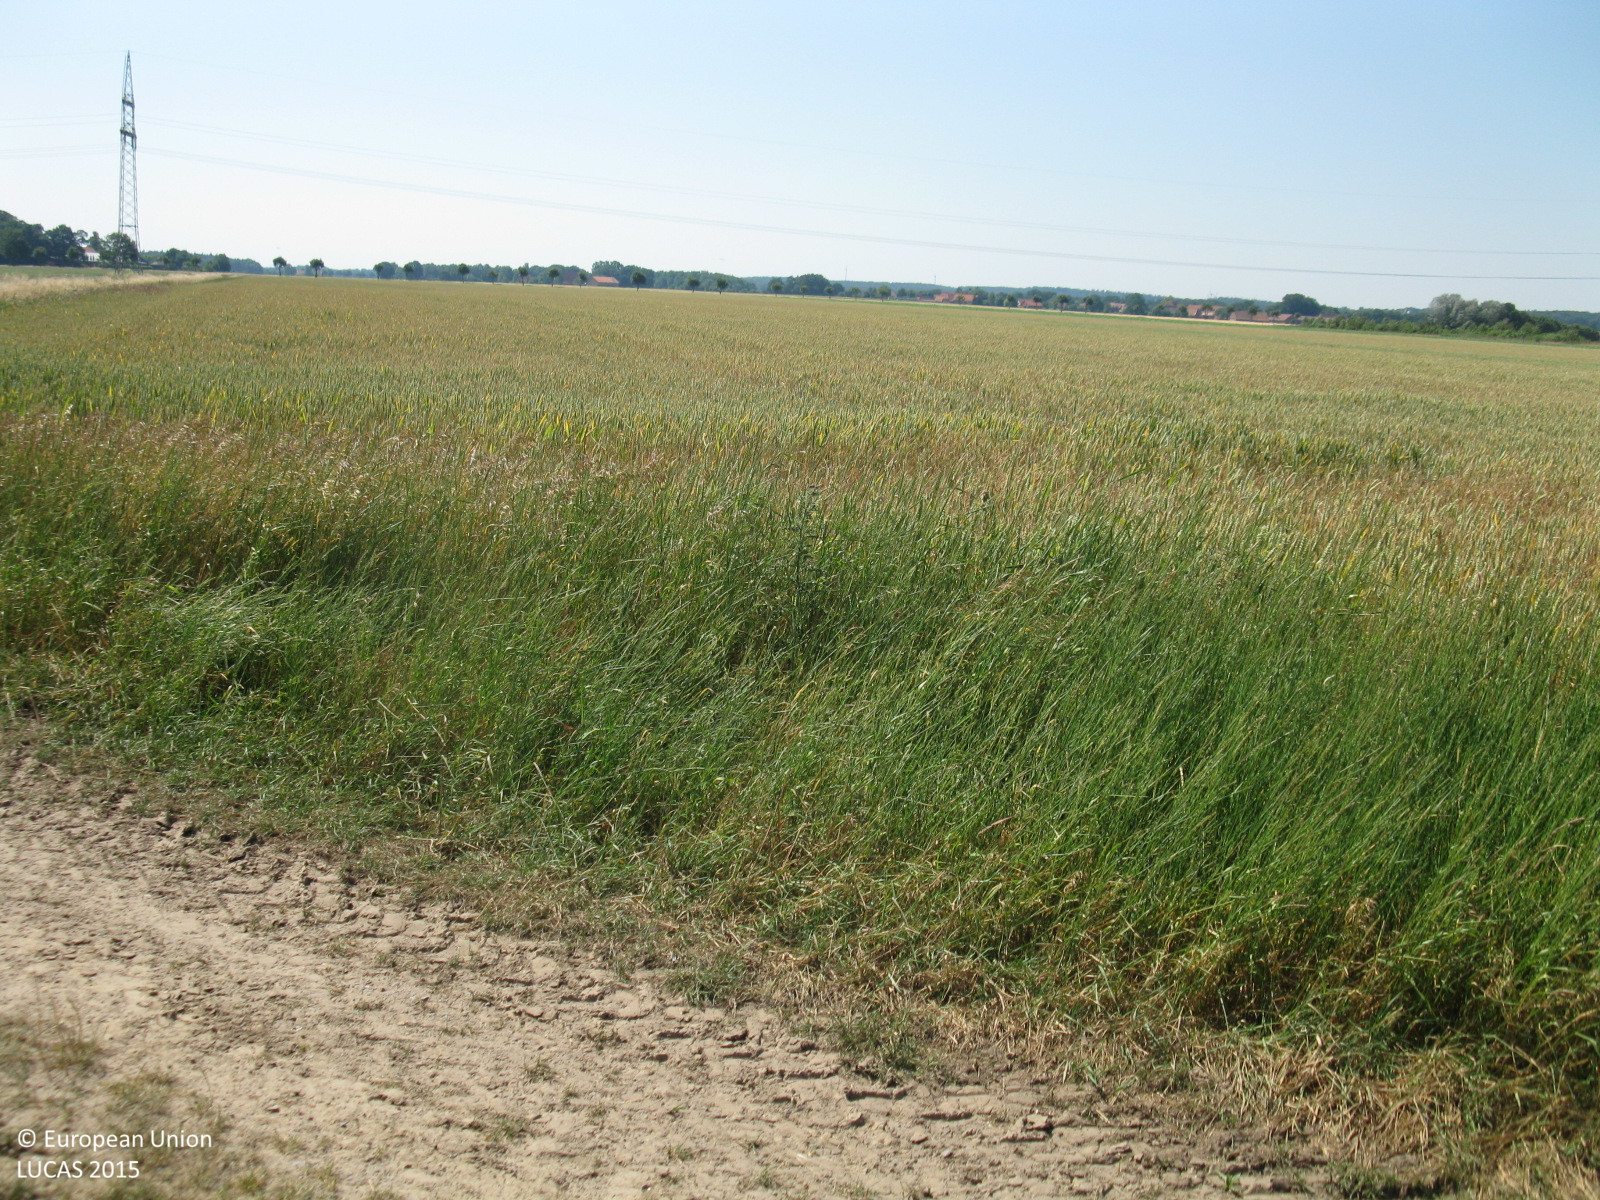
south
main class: Grassland
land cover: Grassland with sparse tree/shrub cover
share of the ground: > 75 %
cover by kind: herbaceous plants 95 %, broadleaved forest trees 5 %
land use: Agriculture (excluding fallow land and kitchen gardens)
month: July
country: DE
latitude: 52.8413
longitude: 9.0947
